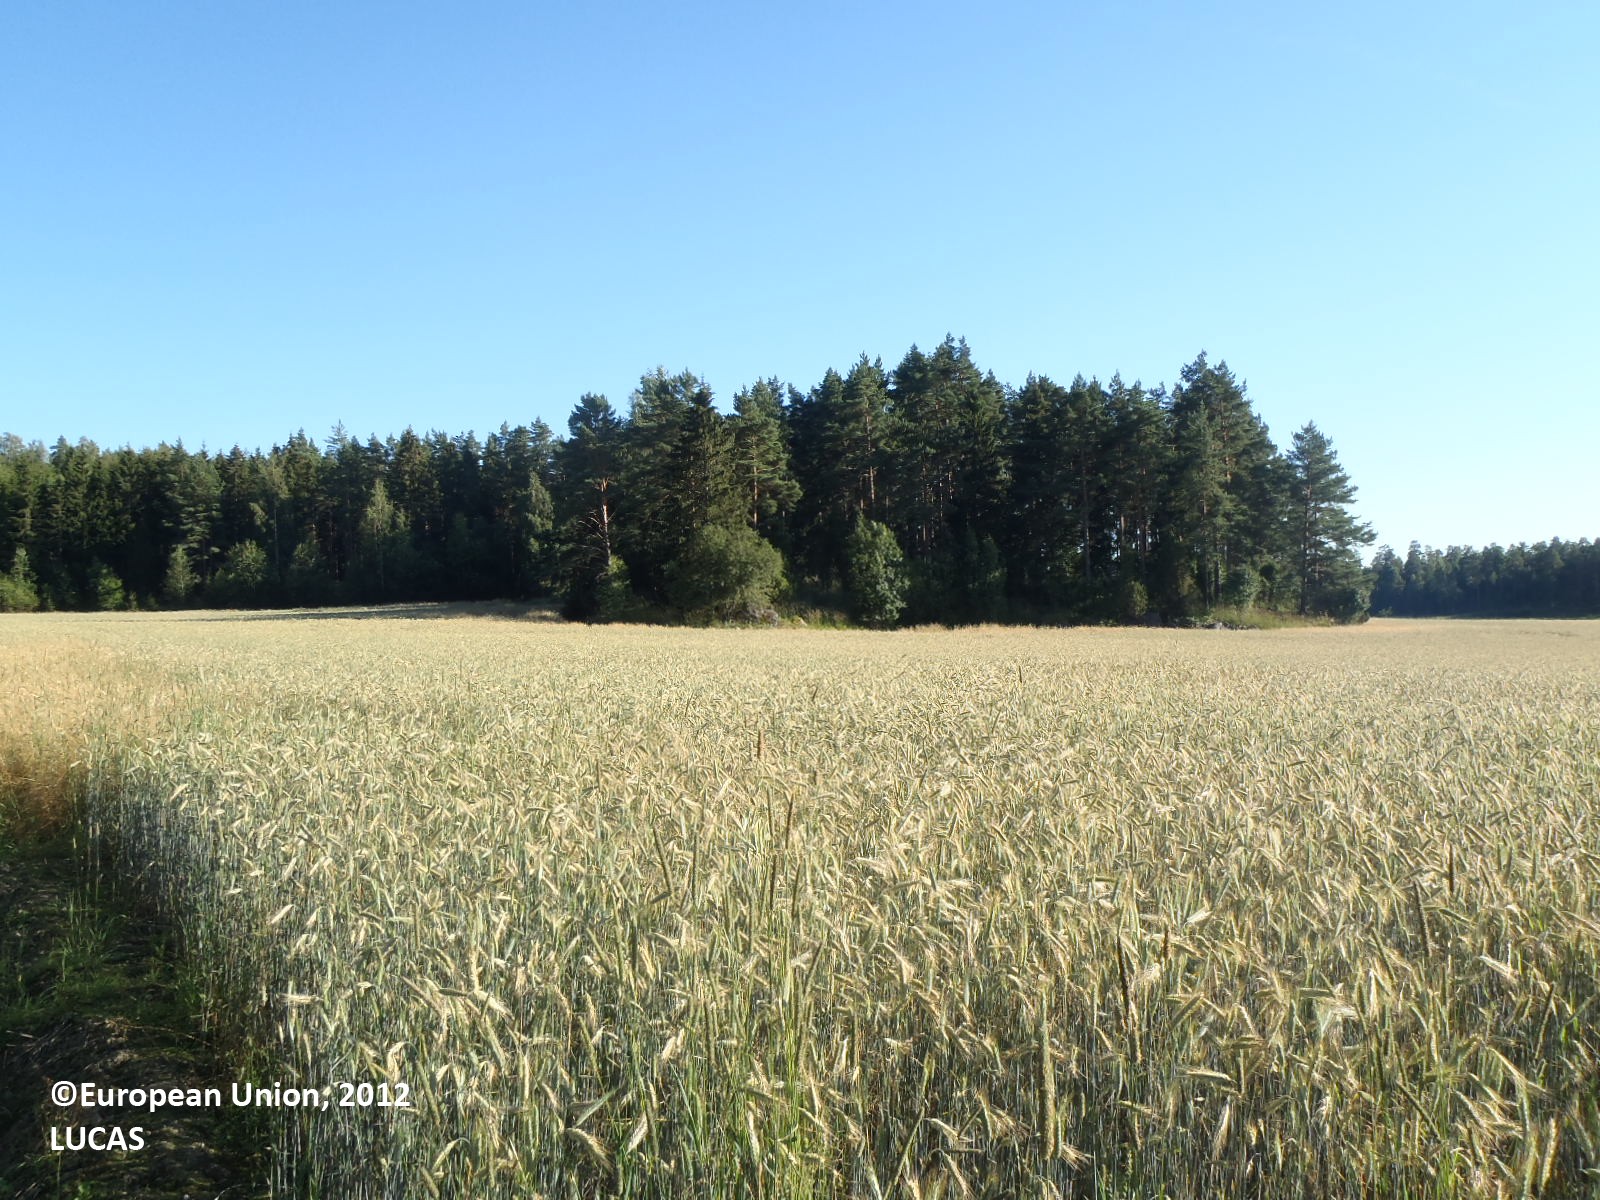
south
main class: Cropland
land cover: Mixed cereals for fodder
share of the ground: > 75 %
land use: Agriculture (excluding fallow land and kitchen gardens)
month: July
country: FI
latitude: 60.6038
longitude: 21.9146
